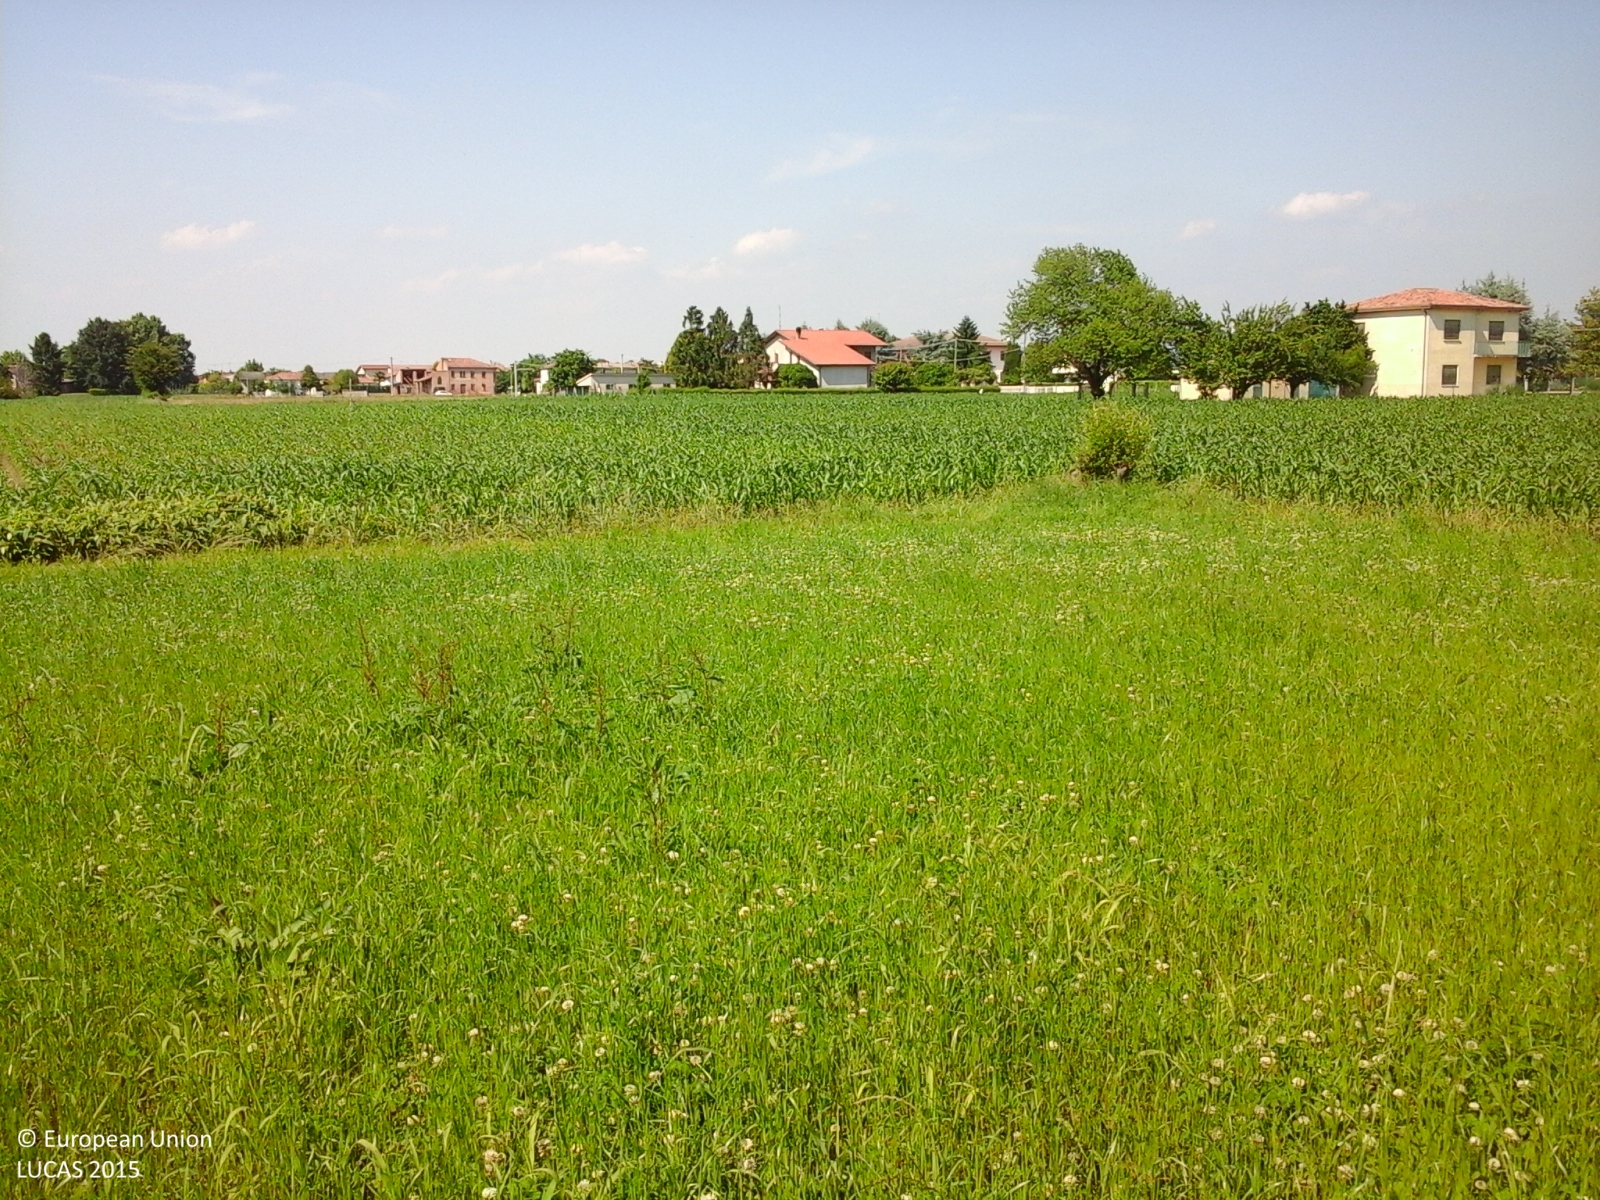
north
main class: Grassland
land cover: Spontaneously vegetated surfaces
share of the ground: > 75 %
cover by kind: herbaceous plants 100 %
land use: Agriculture (excluding fallow land and kitchen gardens)
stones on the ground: < 10 %
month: May
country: IT
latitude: 45.2044
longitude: 11.5631
